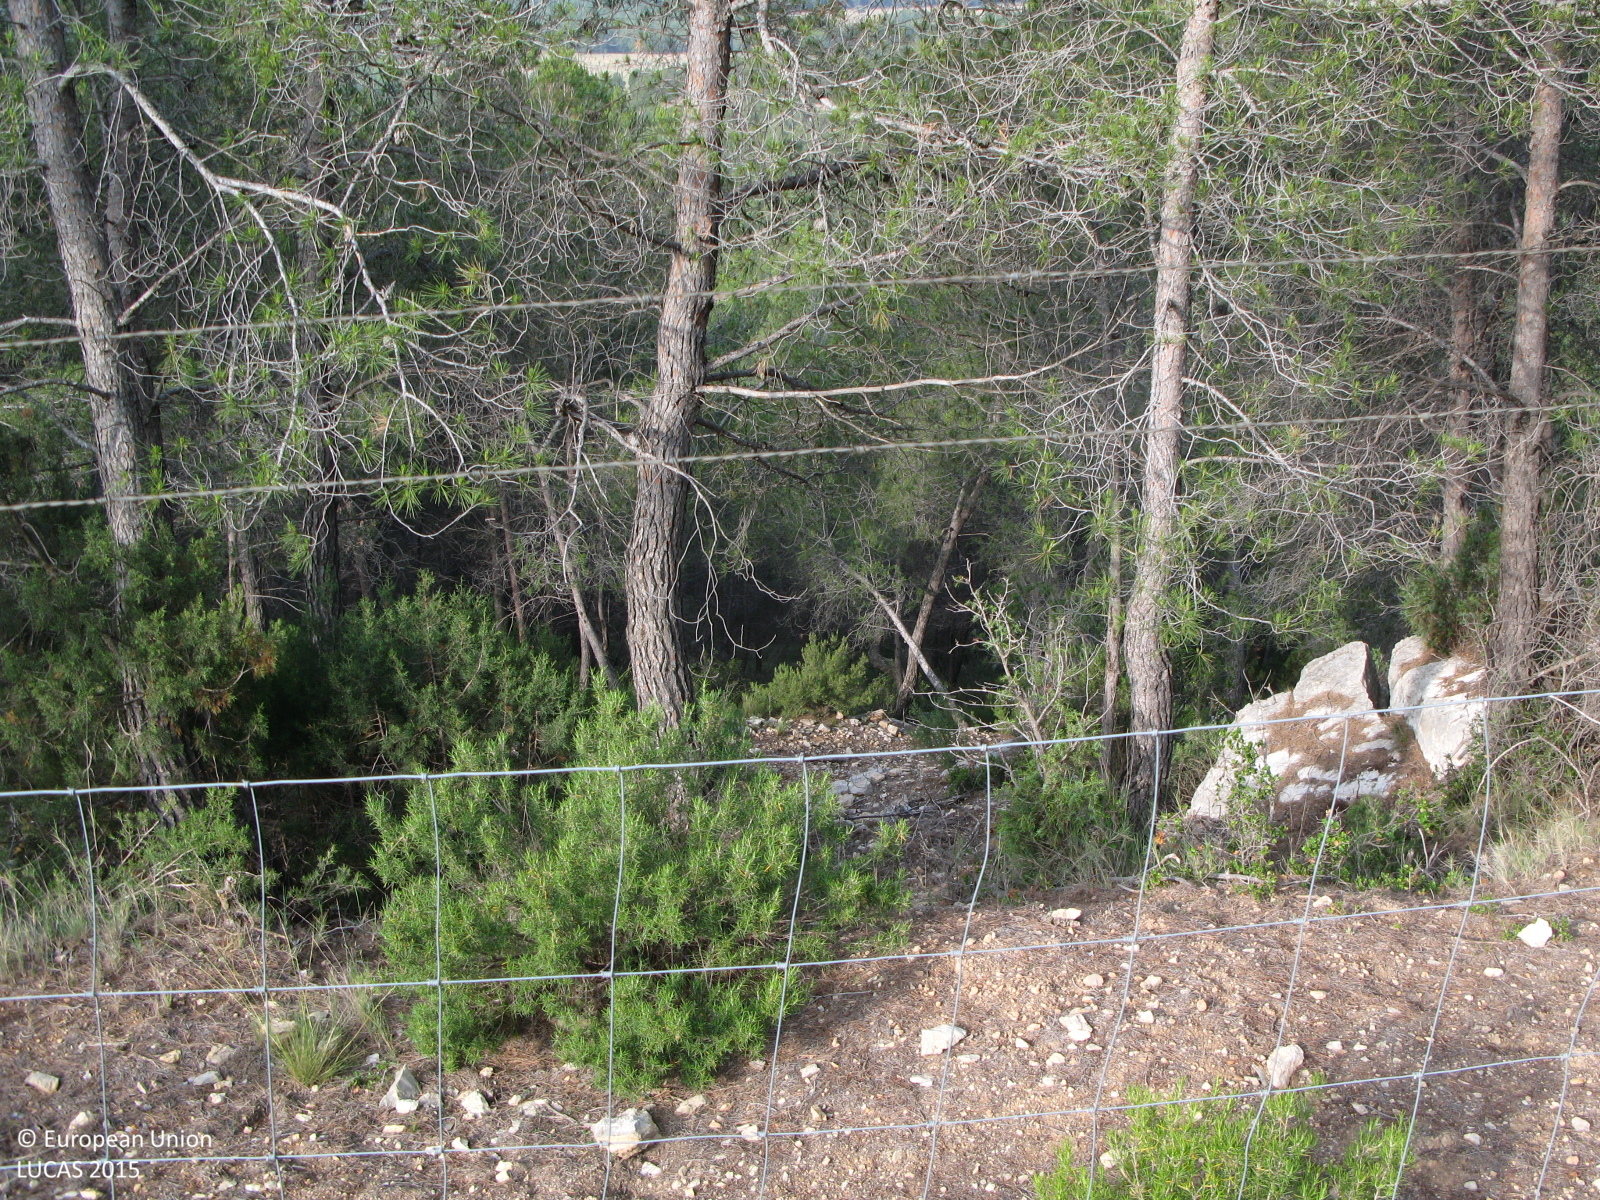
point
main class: Woodland
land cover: Pine dominated coniferous woodland
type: coniferous forest of the mediterranean region
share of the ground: > 75 %
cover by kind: coniferous forest trees 80 %, shrubs 20 %
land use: Forestry
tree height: > 5 m
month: June
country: ES
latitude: 39.8646
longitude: -1.1701
